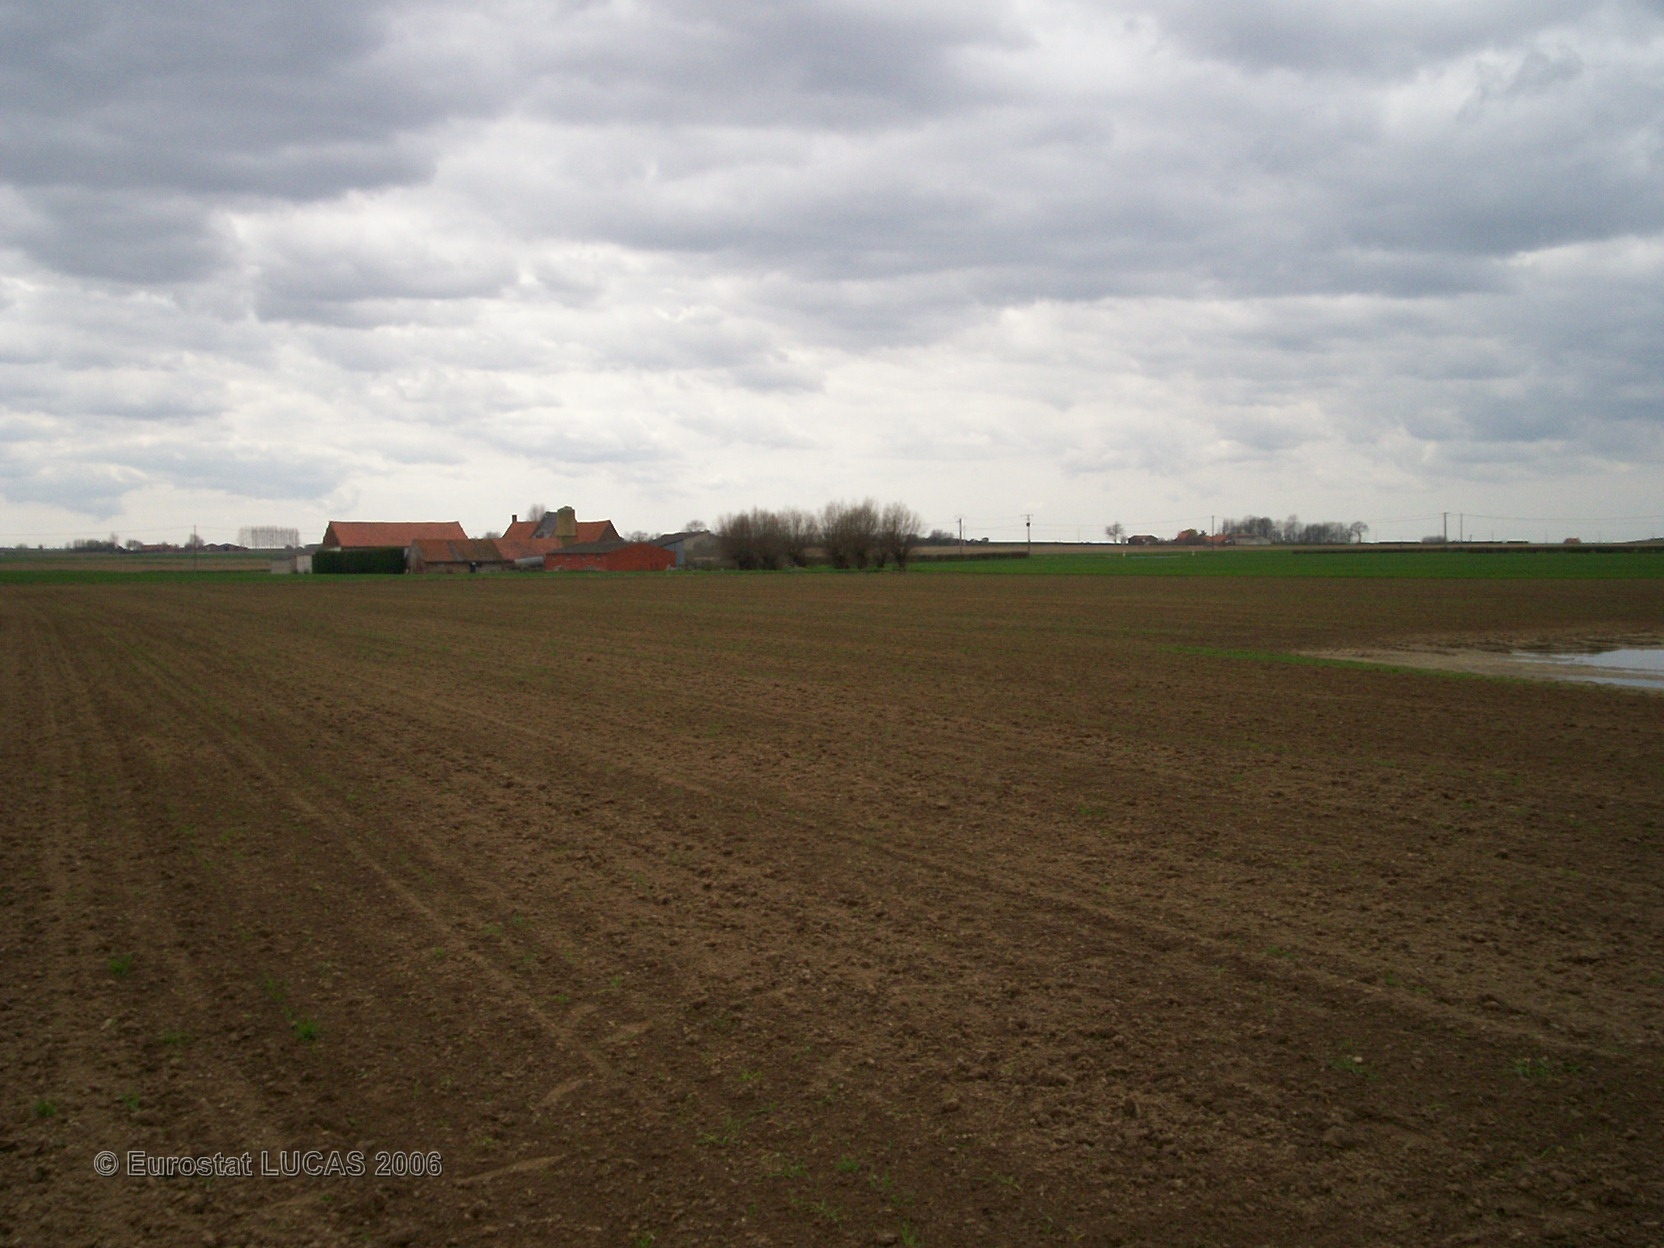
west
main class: Cropland
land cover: Common wheat
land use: Agriculture (excluding fallow land and kitchen gardens)
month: April
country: FR
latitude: 50.9062
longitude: 2.4069
